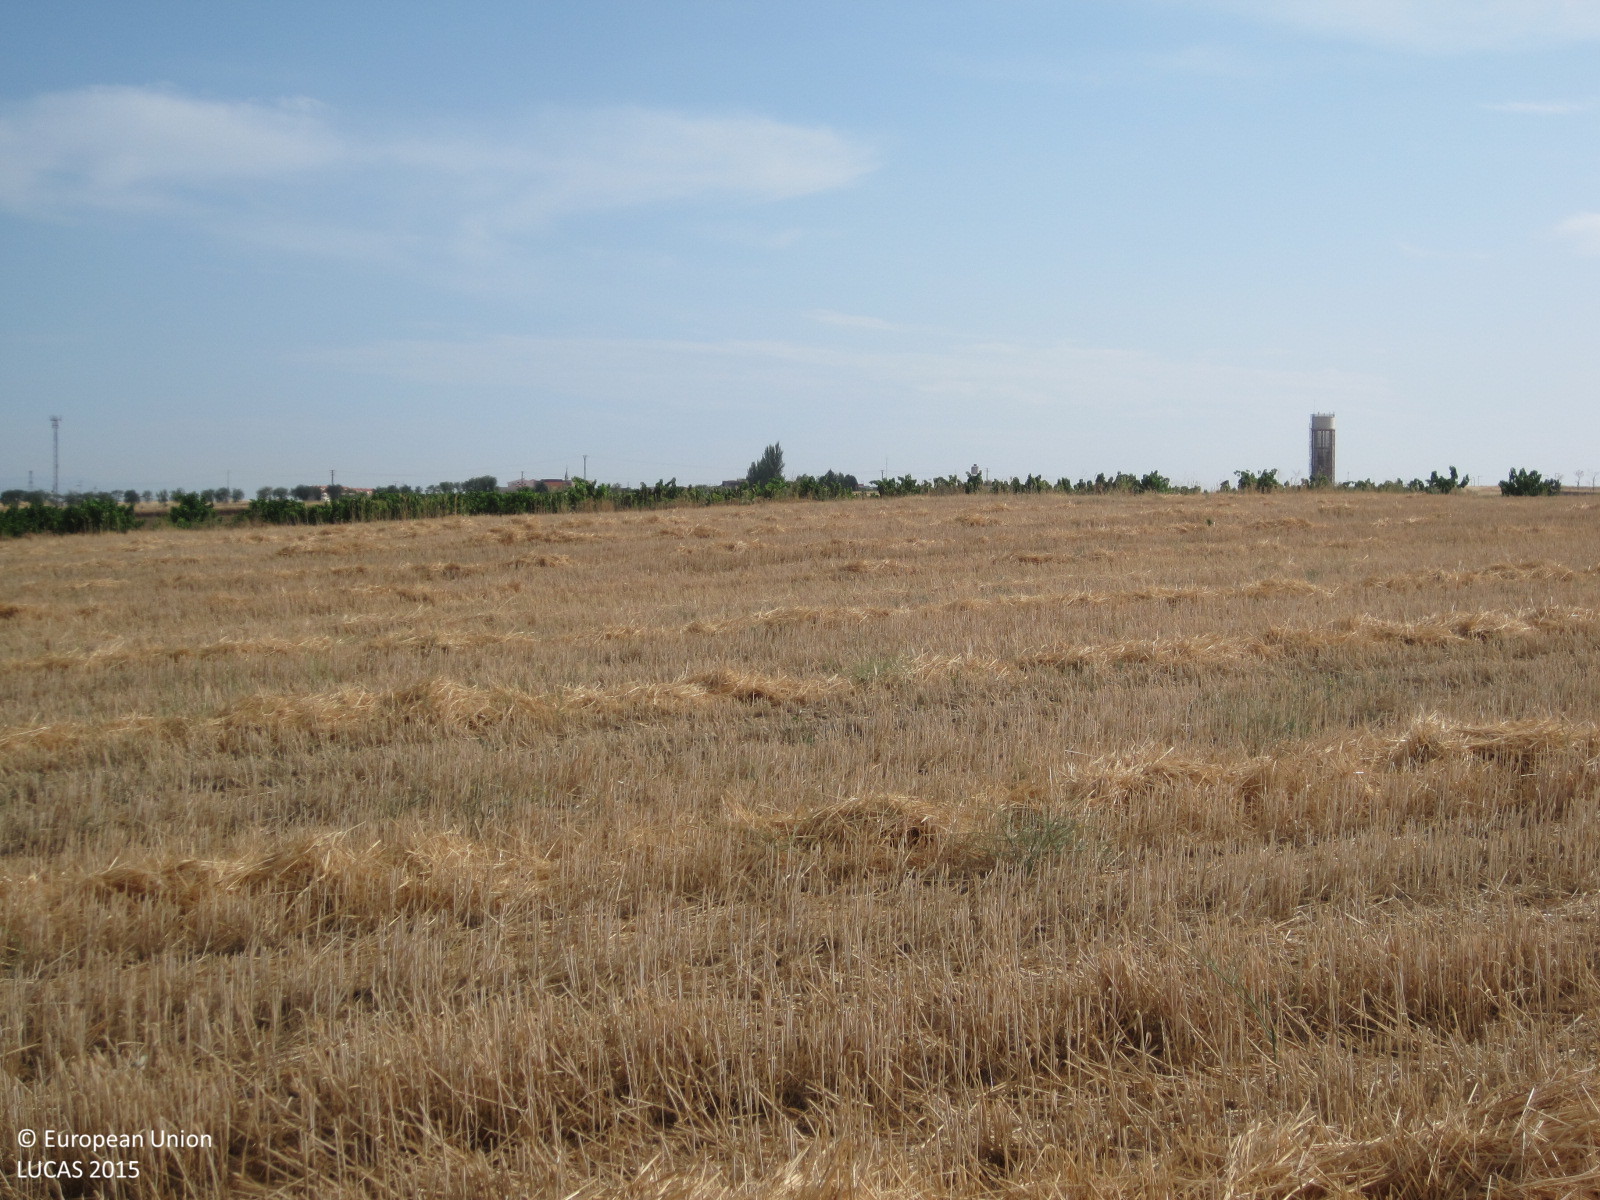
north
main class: Cropland
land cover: Common wheat
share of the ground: < 10 %
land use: Agriculture (excluding fallow land and kitchen gardens)
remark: Harvested field
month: July
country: ES
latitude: 40.0487
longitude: -4.2348
